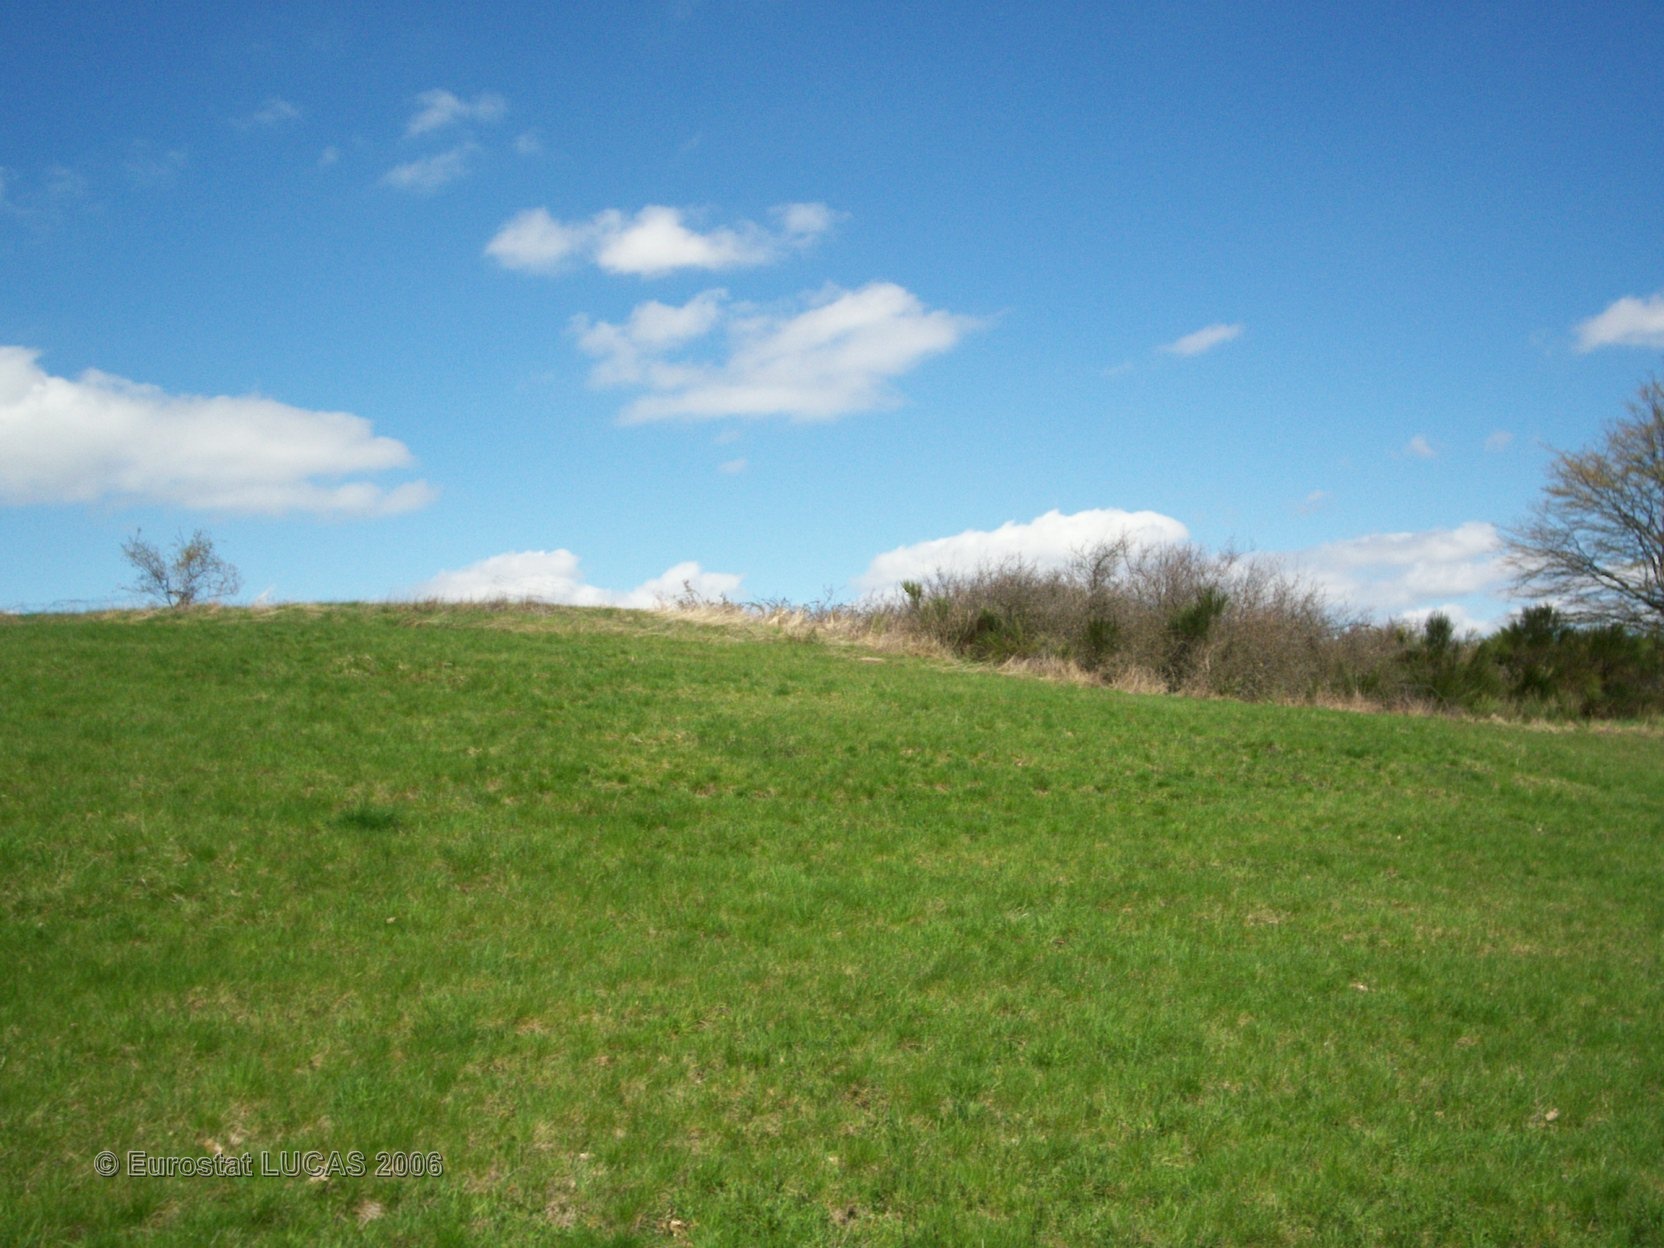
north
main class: Grassland
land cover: Grassland without tree/shrub cover
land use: Agriculture (excluding fallow land and kitchen gardens)
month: April
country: FR
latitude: 46.4379
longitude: 4.7306
